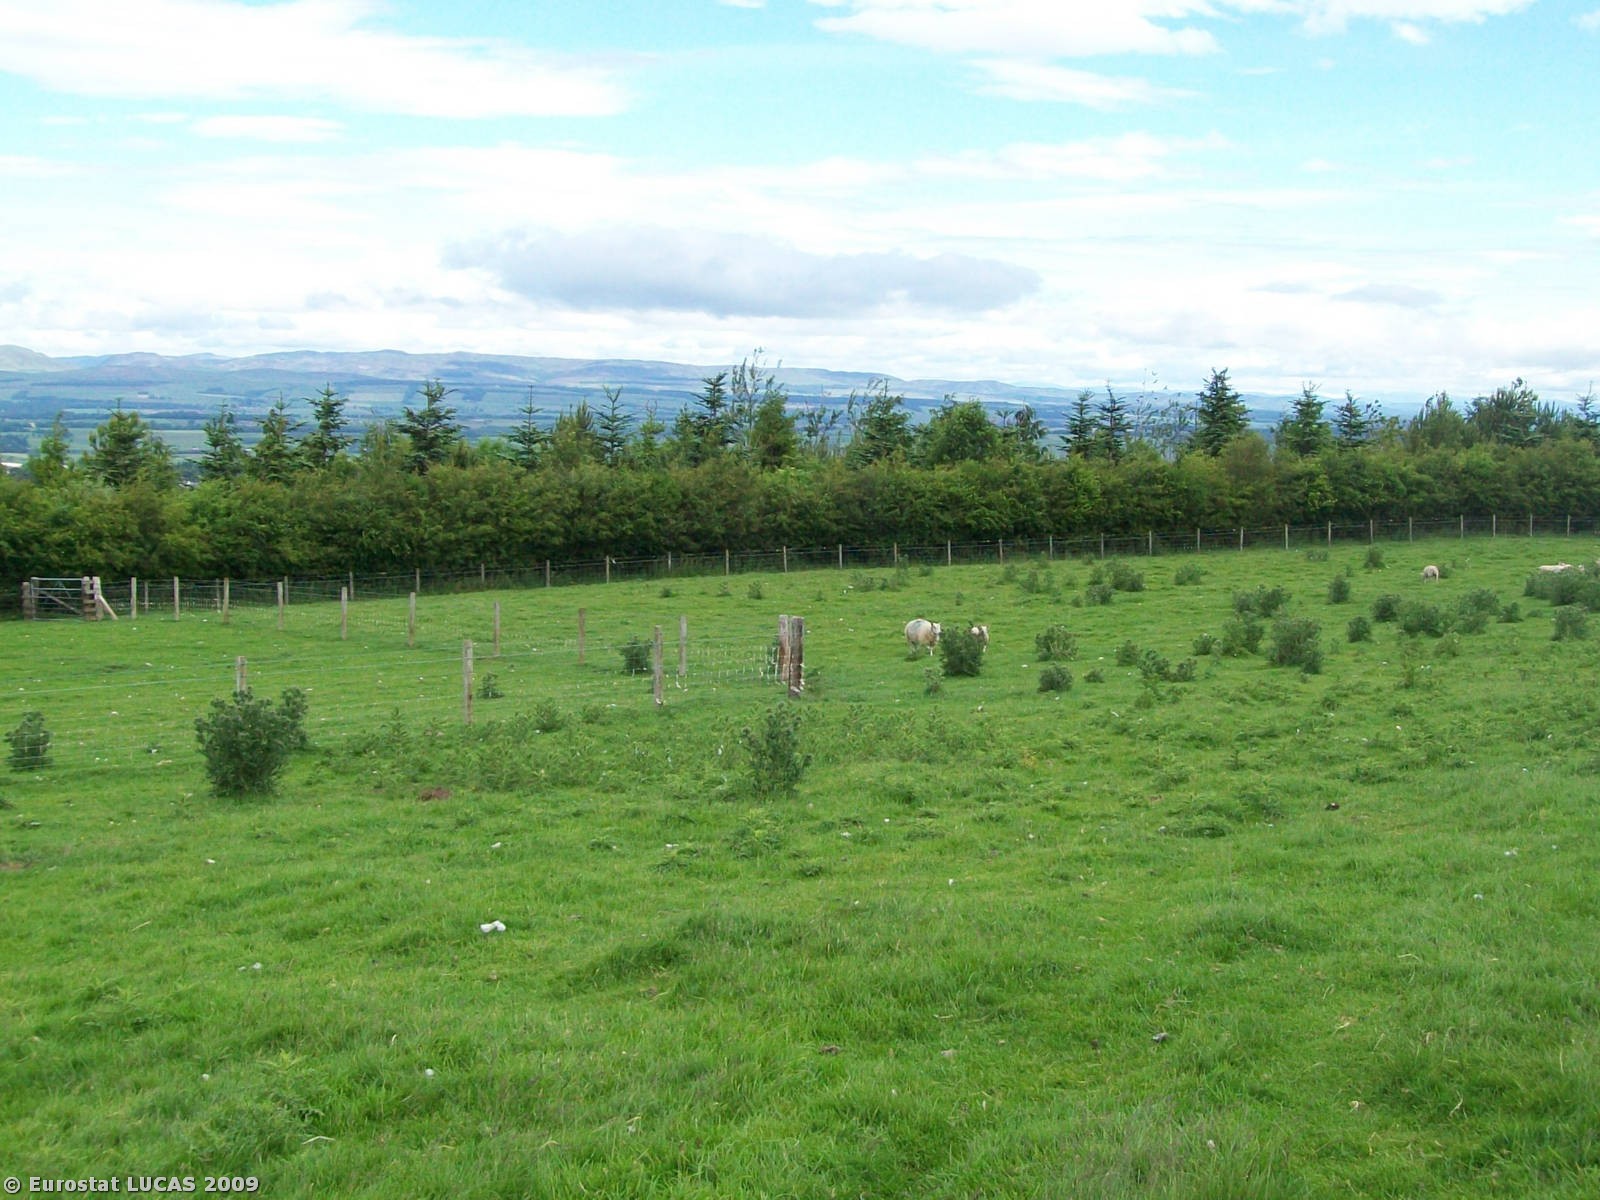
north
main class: Grassland
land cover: Grassland without tree/shrub cover
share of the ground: > 75 %
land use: Agriculture (excluding fallow land and kitchen gardens)
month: June
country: GB
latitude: 56.2711
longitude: -3.6927
